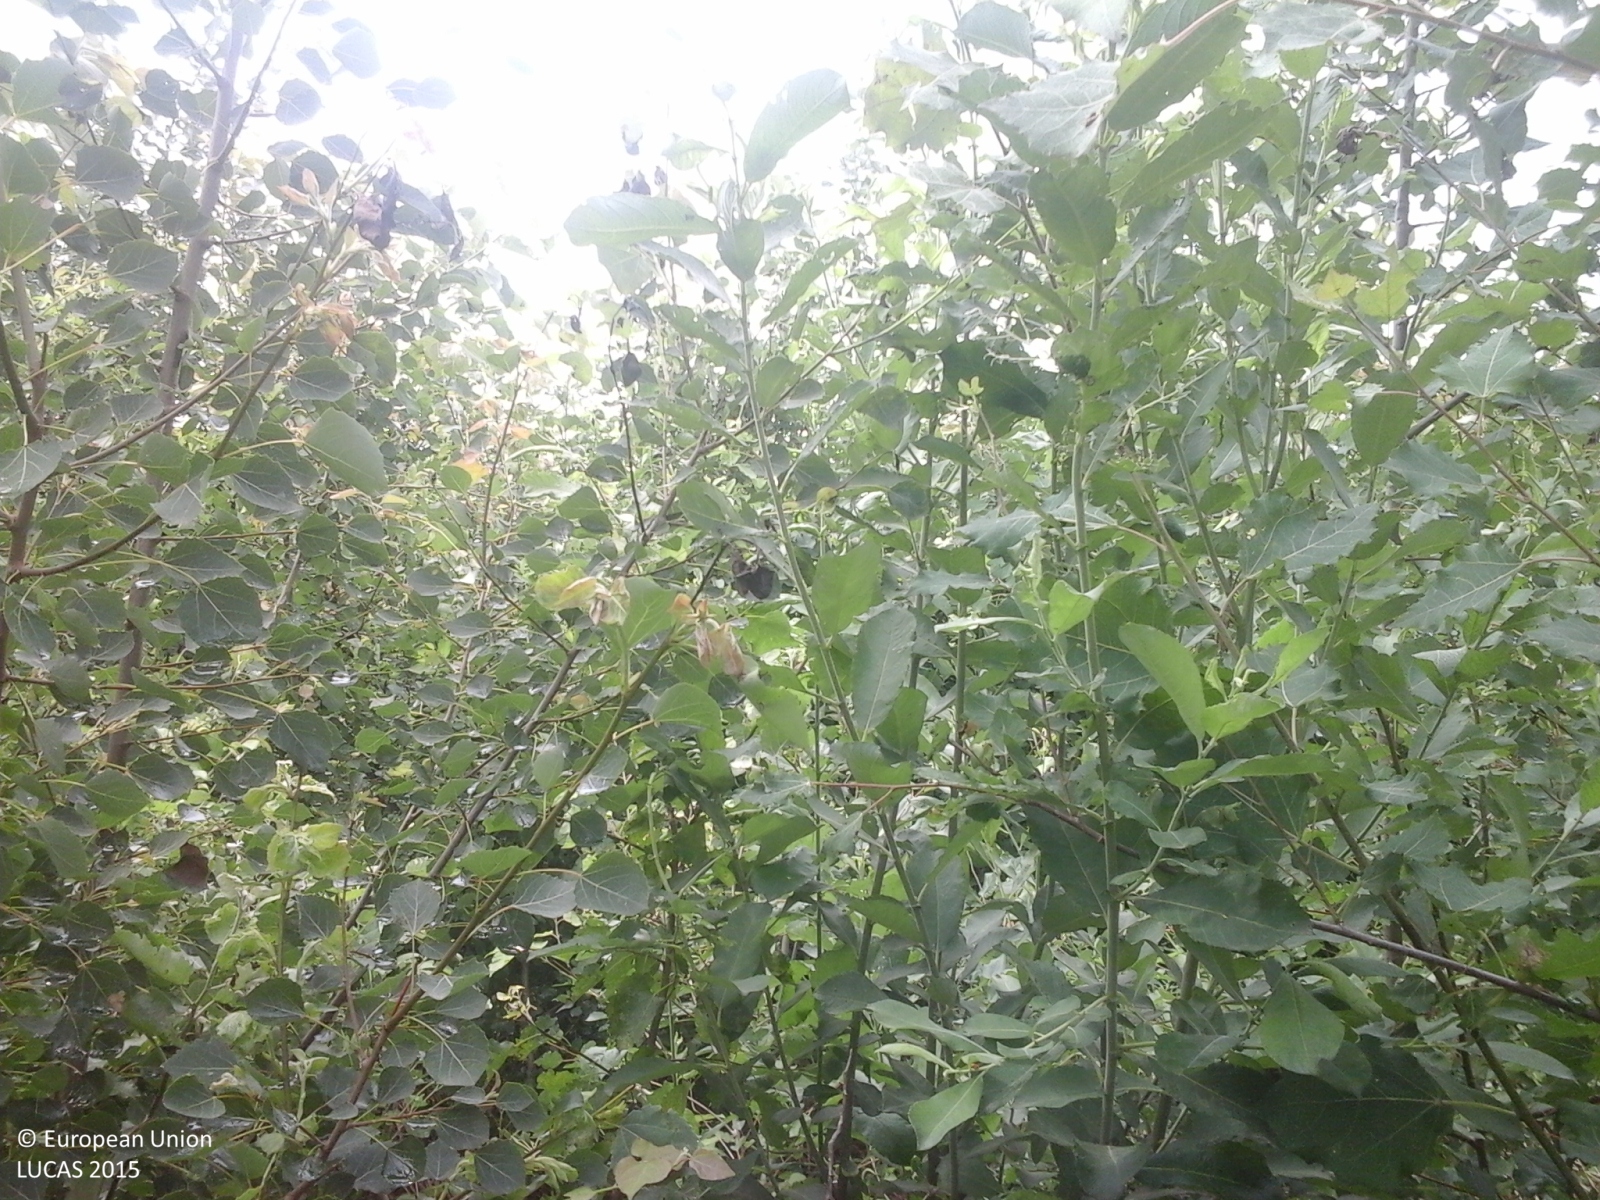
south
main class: Woodland
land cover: Broadleaved woodland
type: non-riverine alder, birch or aspen forest
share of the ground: > 75 %
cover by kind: broadleaved forest trees 70 %, shrubs 20 %, herbaceous plants 10 %
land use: Forestry
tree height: < 5 m
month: June
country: IT
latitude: 45.4354
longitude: 8.2261
